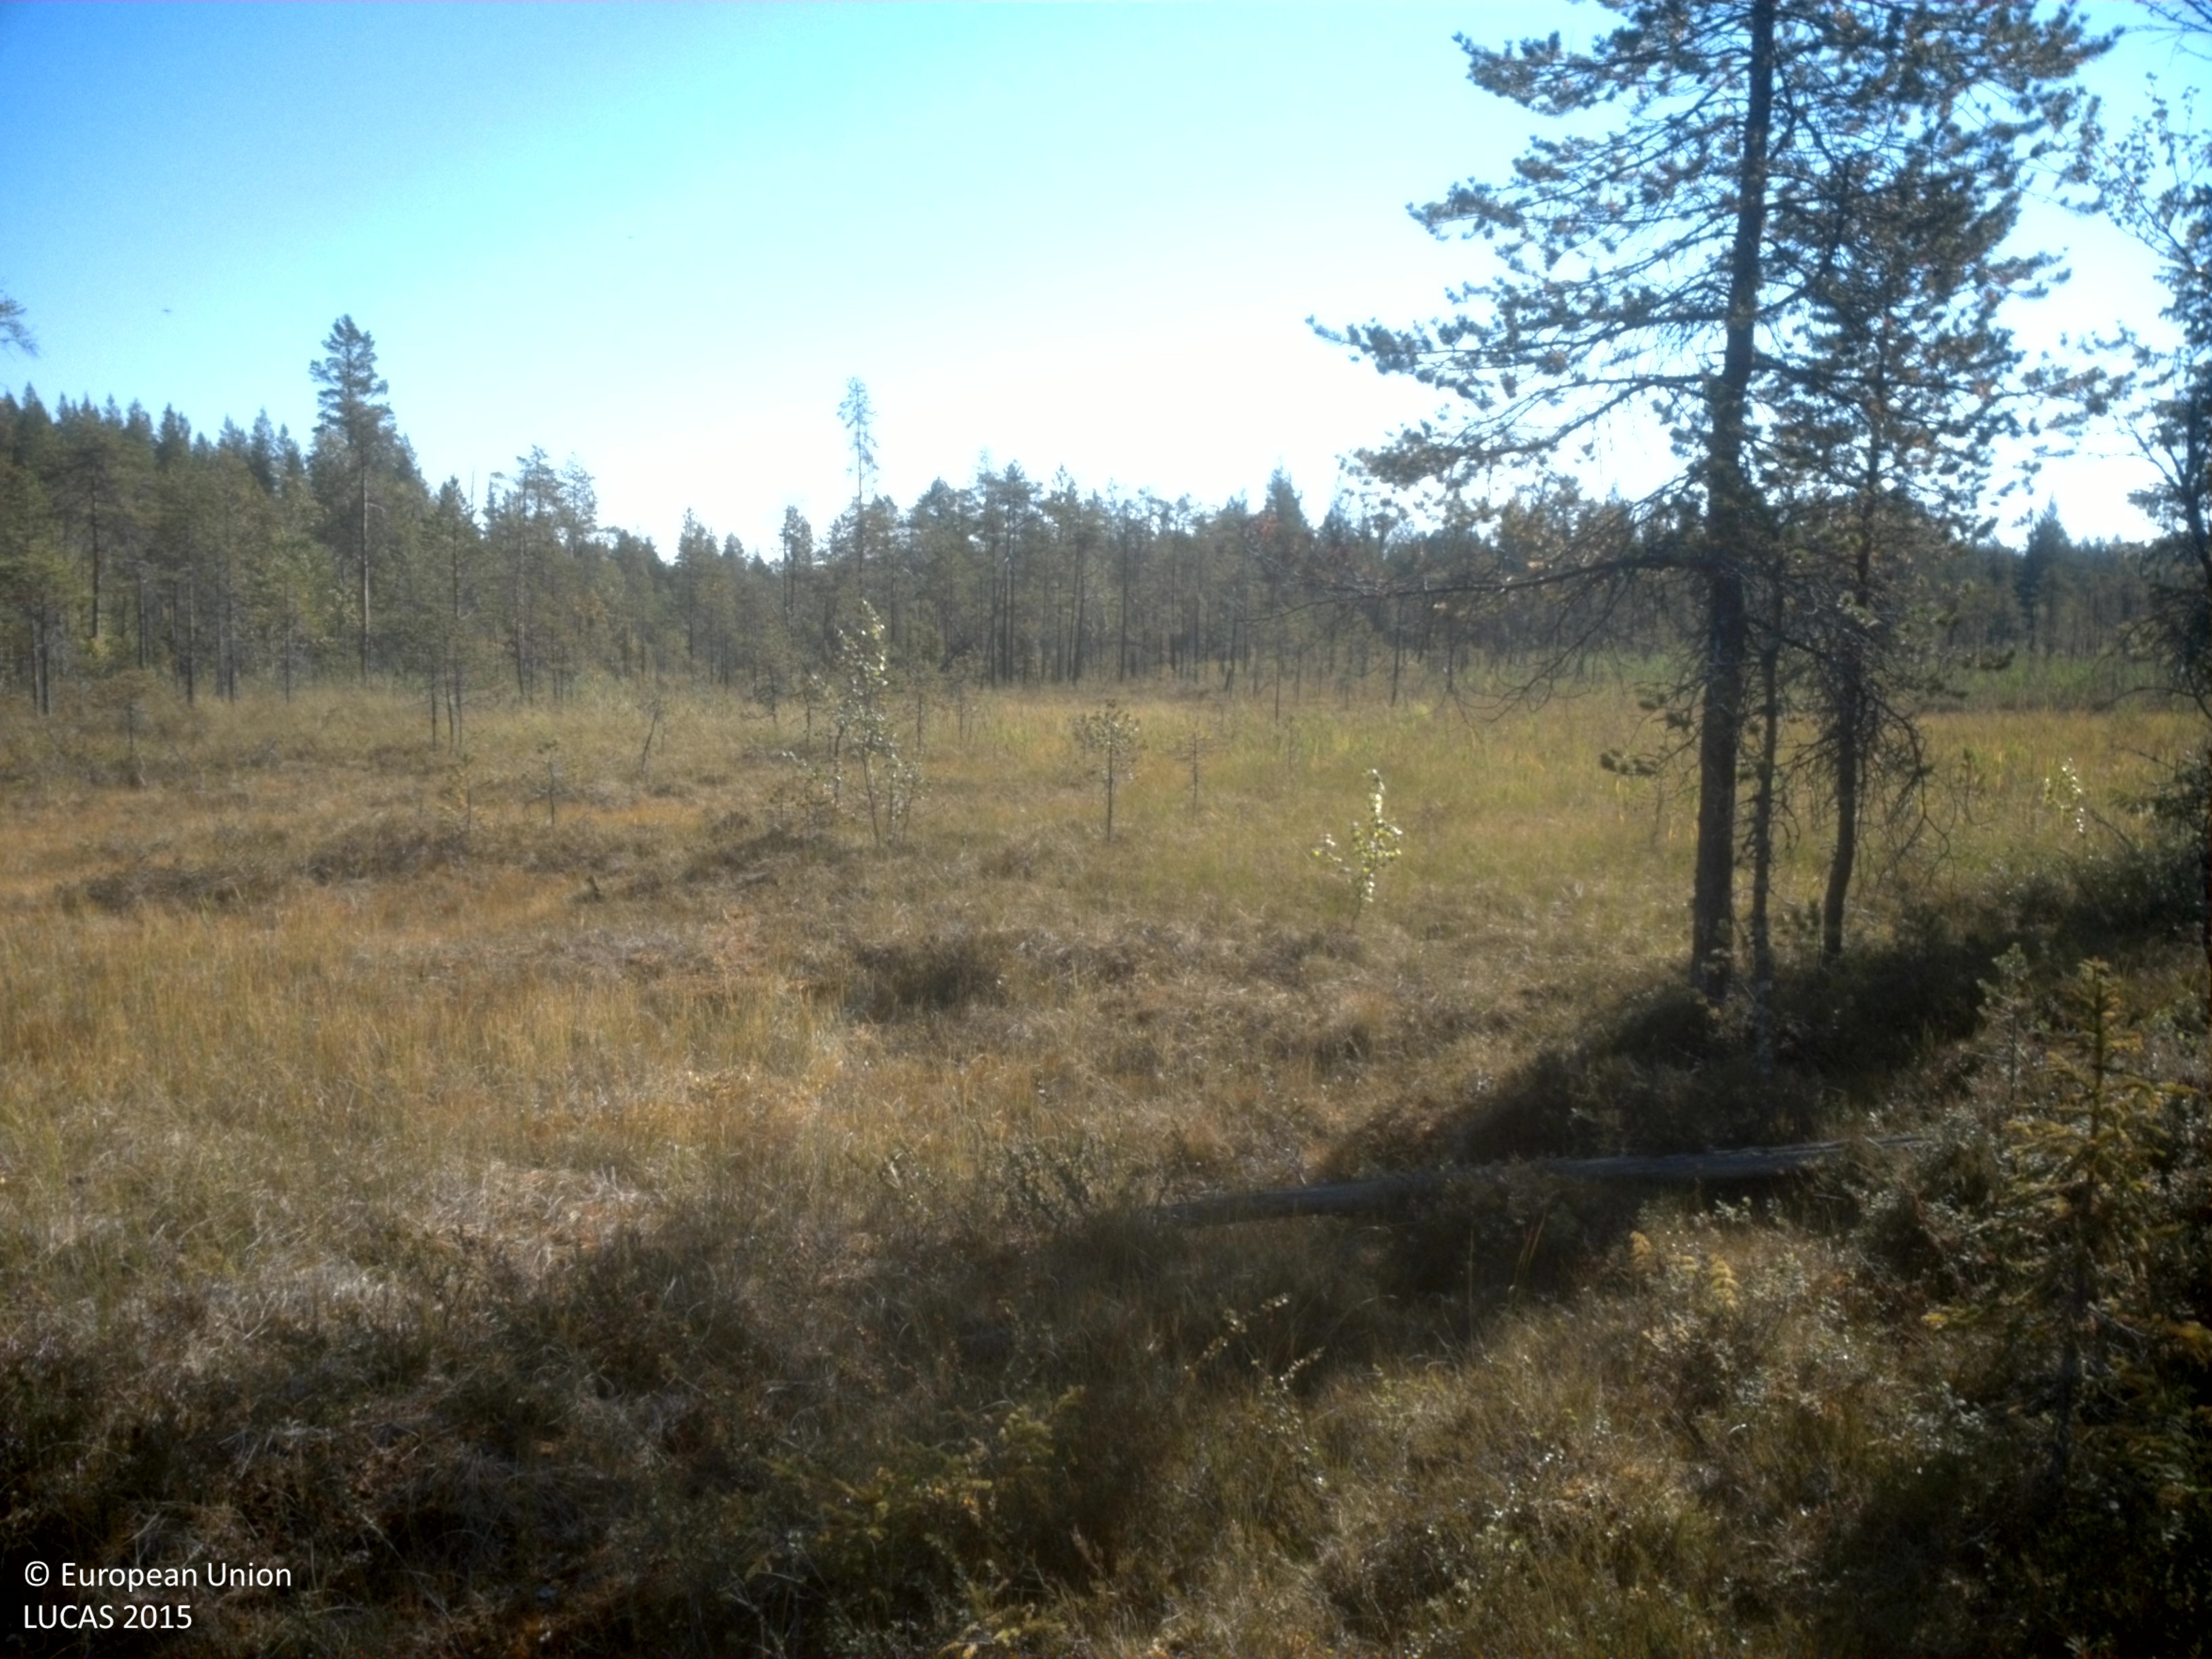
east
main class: Woodland
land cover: Pine dominated mixed woodland
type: boreal forest
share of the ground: 50 - 75 %
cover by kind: coniferous forest trees 45 %, shrubs 20 %, lichens and mosses 20 %, broadleaved forest trees 15 %
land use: Forestry
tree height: > 5 m
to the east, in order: Pine dominated mixed woodland; Peatbogs; Pine dominated coniferous woodland; Tracks; Pine dominated coniferous woodland; Pine dominated mixed woodland; Rivers and streams; Inland marshes; Pine dominated mixed woodland; Rivers and streams; Pine dominated mixed woodland
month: August
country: SE
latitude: 64.7152
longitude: 18.8435
